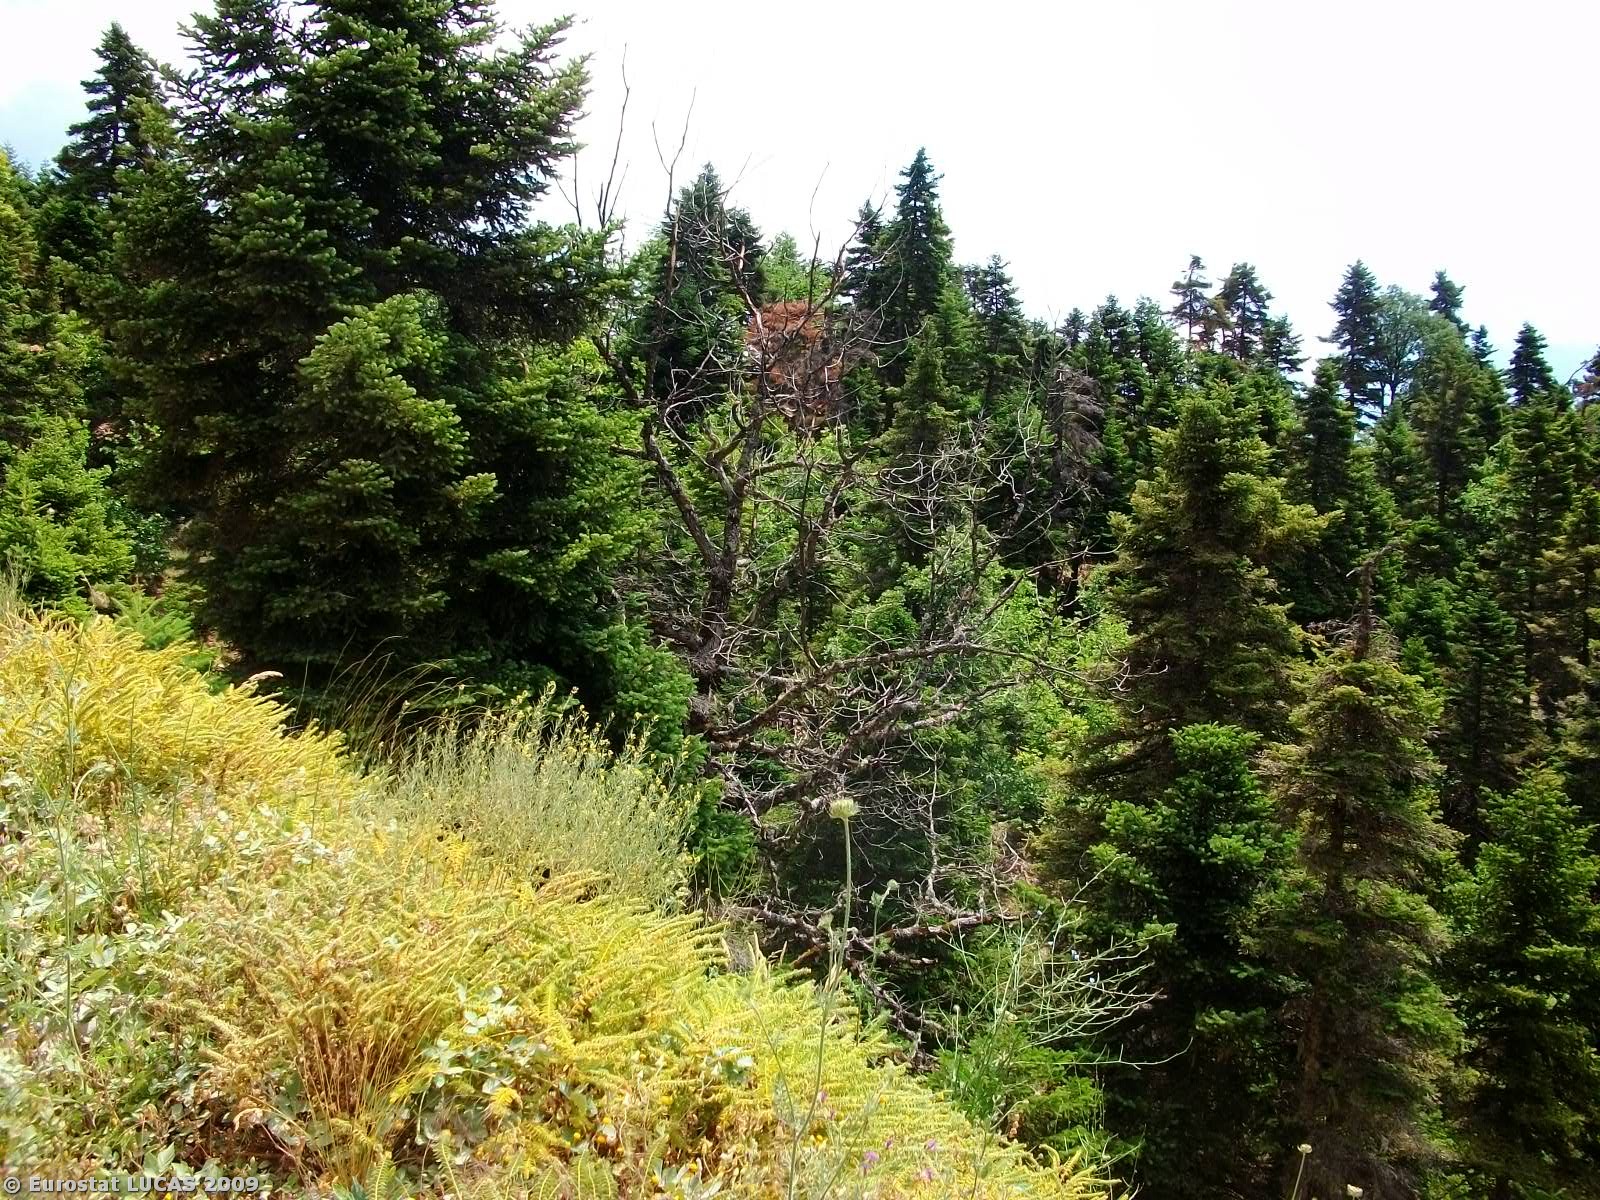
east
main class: Woodland
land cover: Coniferous woodland
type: coniferous forest of the mediterranean region
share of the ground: > 75 %
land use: Forestry
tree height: > 5 m
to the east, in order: Coniferous woodland; Fences; Coniferous woodland; Fences; Coniferous woodland
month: June
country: GR
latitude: 38.7192
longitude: 22.1793
